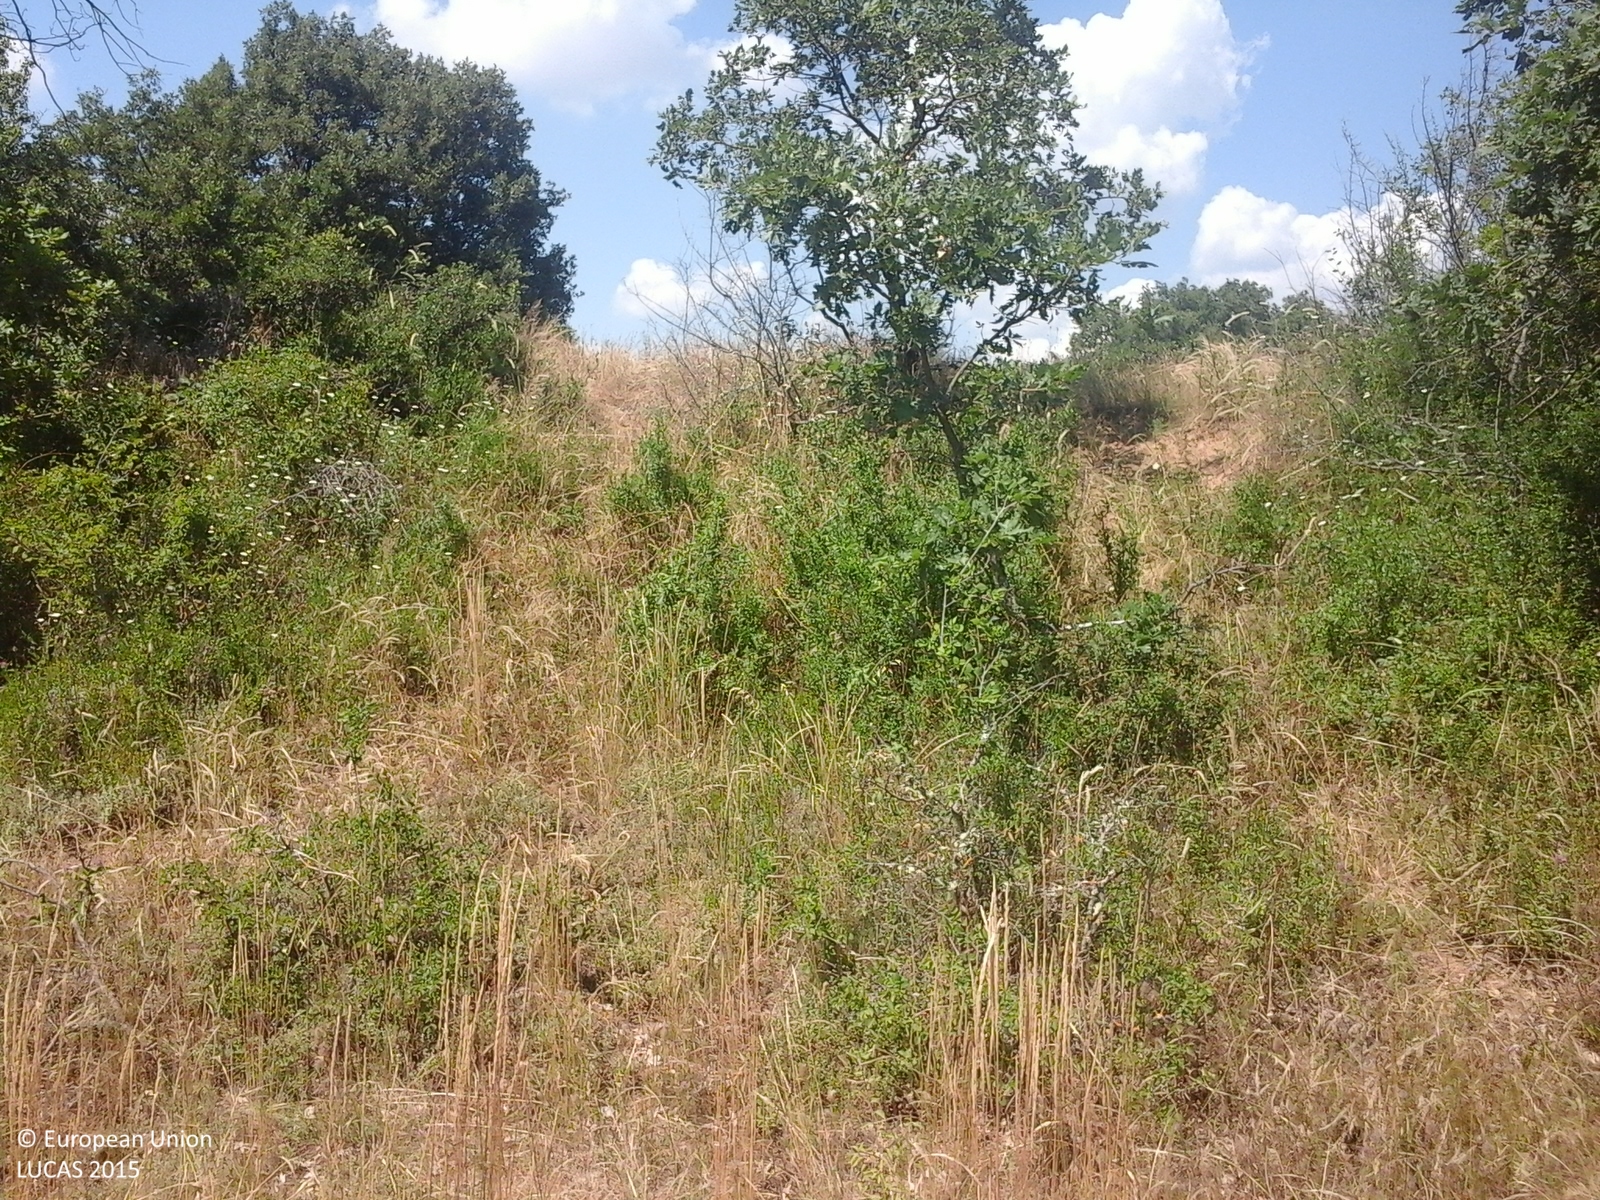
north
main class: Woodland
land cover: Broadleaved woodland
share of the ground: > 75 %
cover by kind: broadleaved forest trees 100 %
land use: Semi-natural and natural areas not in use
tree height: > 5 m
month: June
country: GR
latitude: 40.8368
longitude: 23.1881
